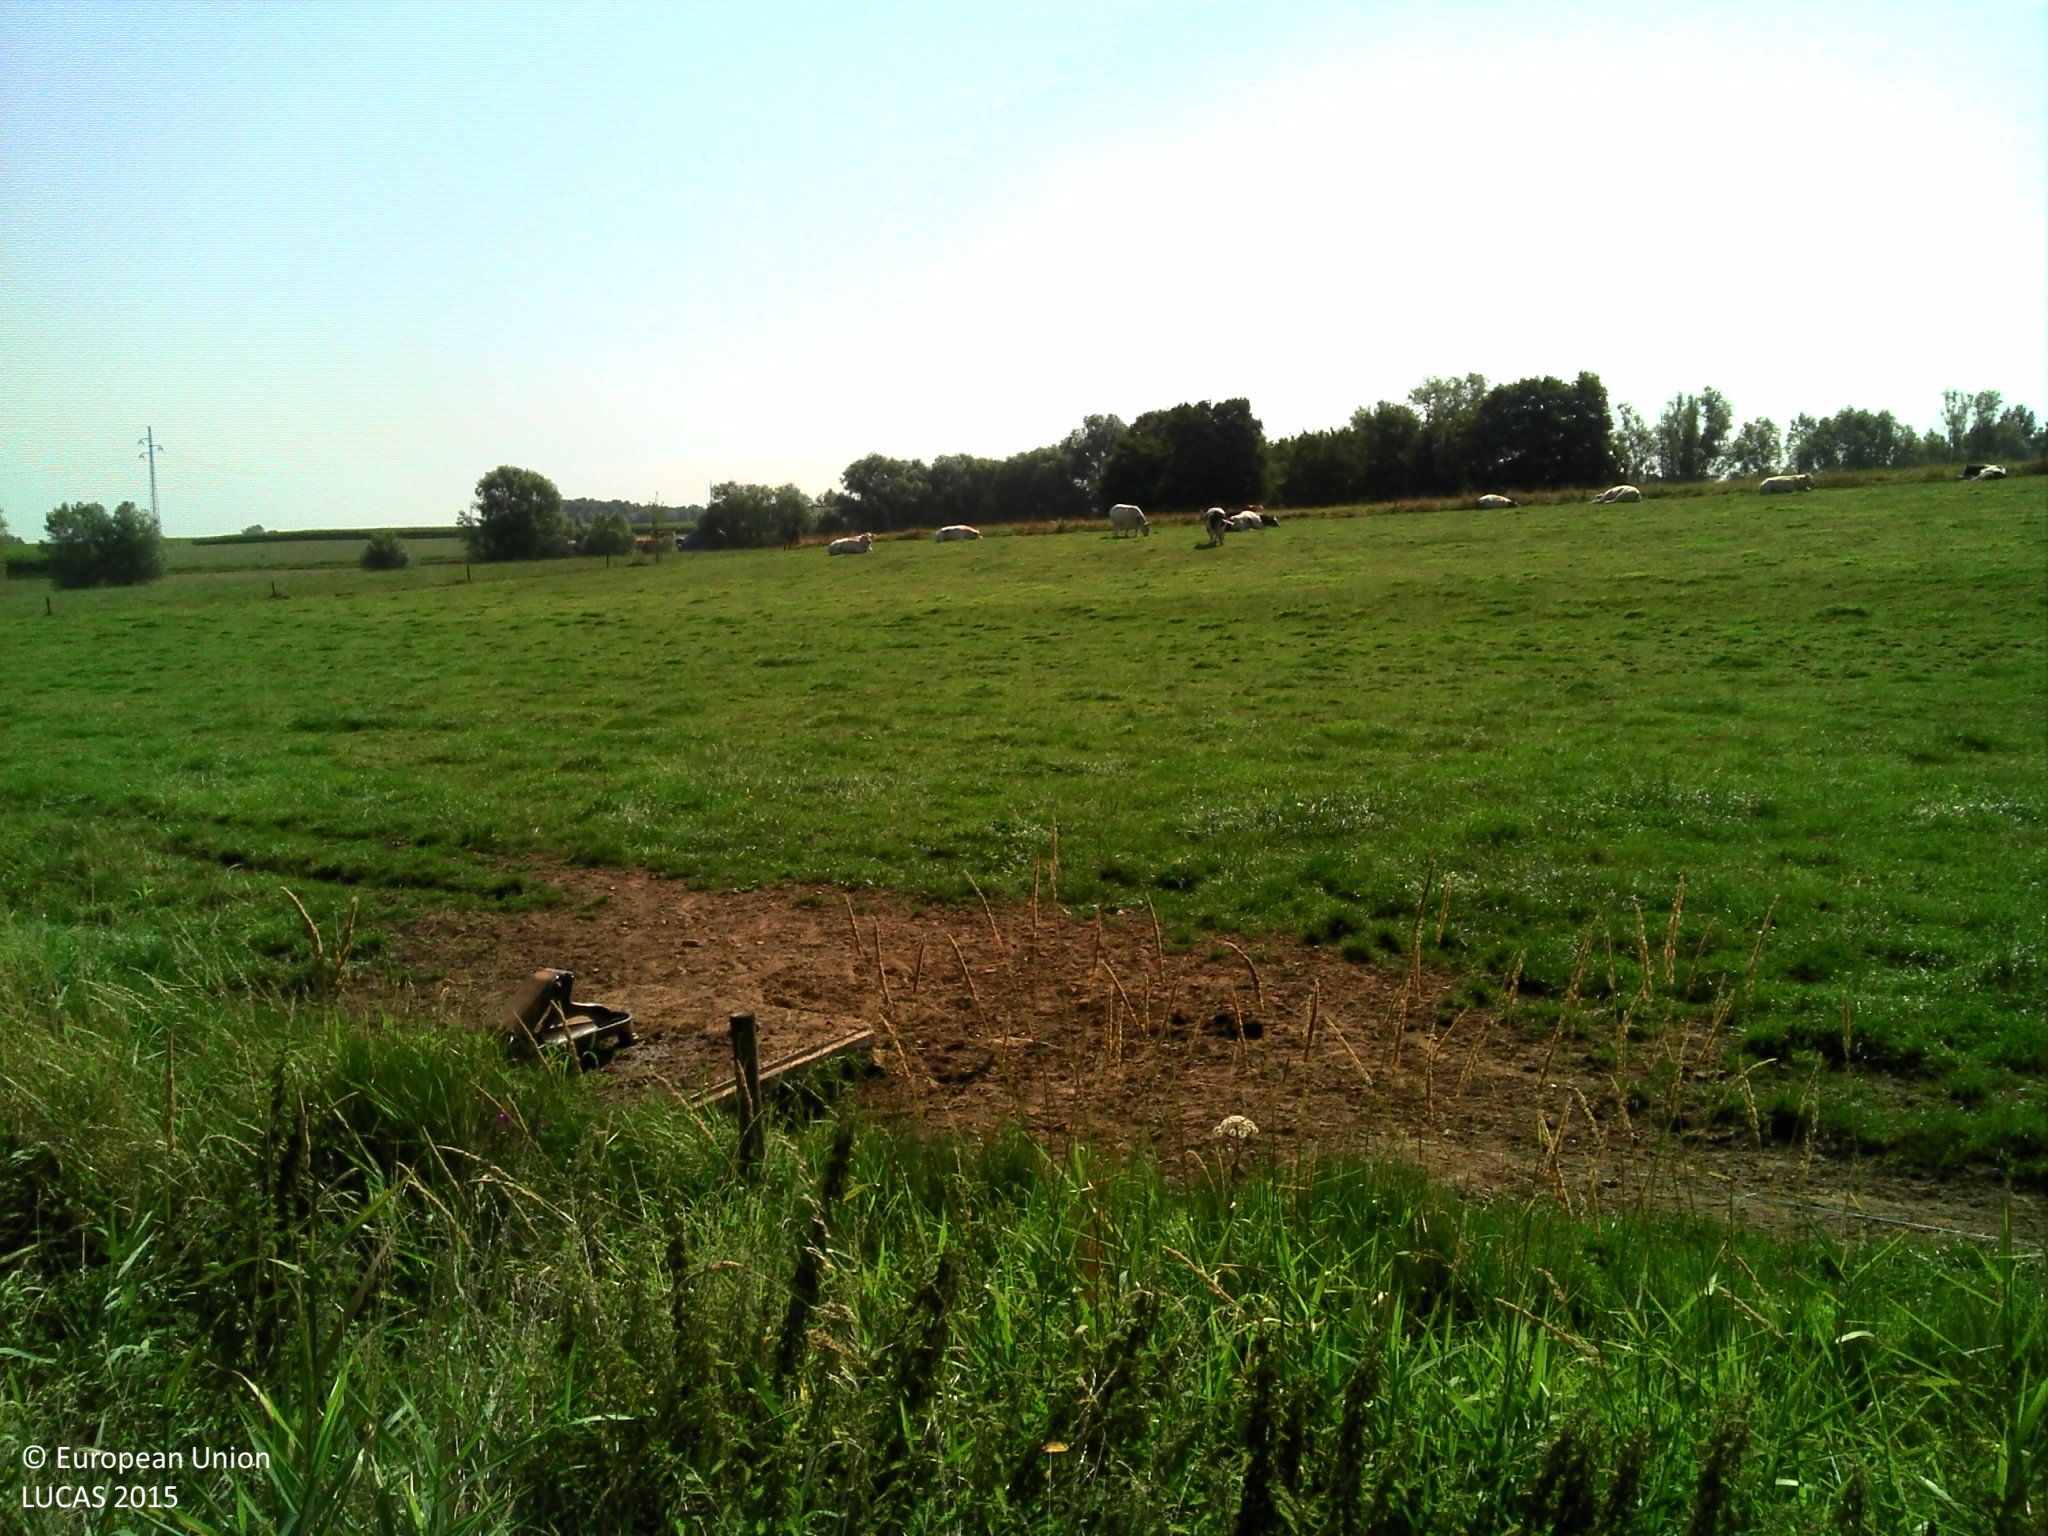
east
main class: Grassland
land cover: Spontaneously vegetated surfaces
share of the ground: > 75 %
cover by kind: herbaceous plants 100 %
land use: Agriculture (excluding fallow land and kitchen gardens)
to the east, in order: Fences; Rivers and streams; Fences; Grassland without tree/shrub cover; Fences; Grassland without tree/shrub cover
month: August
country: BE
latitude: 50.6758
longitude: 4.0083
